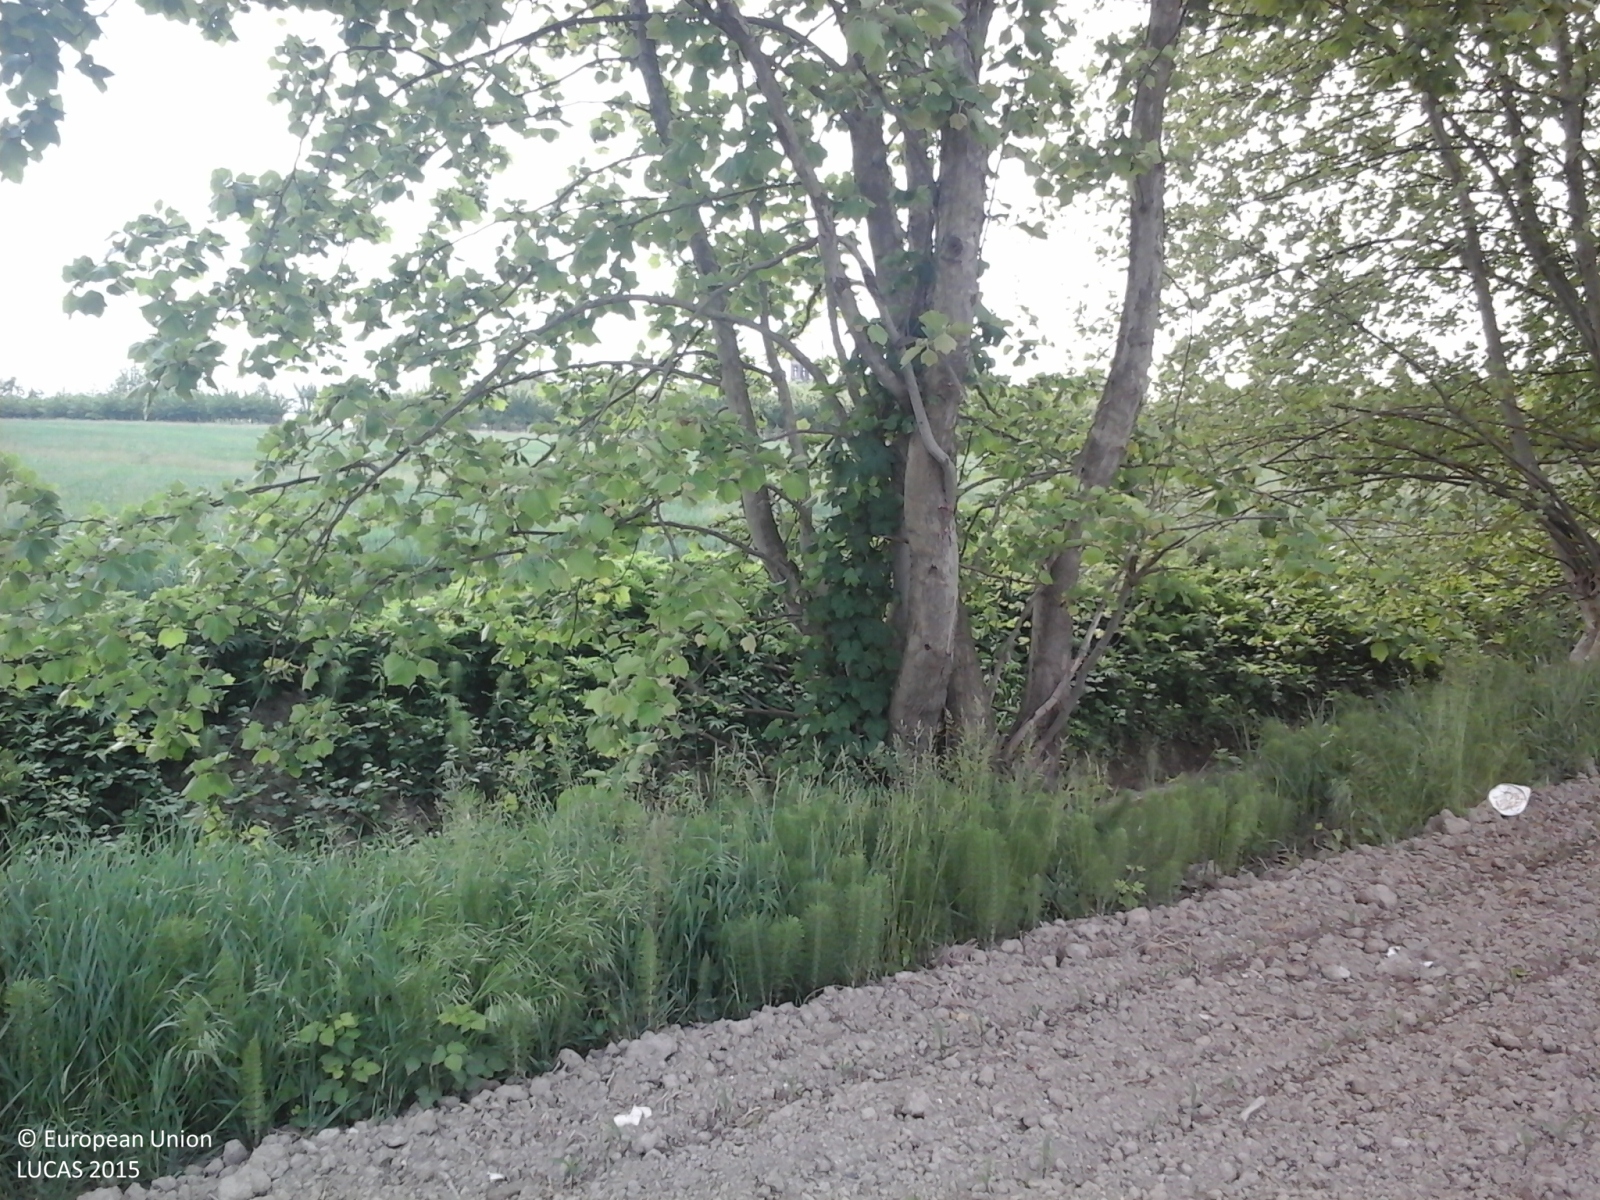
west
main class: Cropland
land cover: Maize
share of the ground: < 10 %
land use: Agriculture (excluding fallow land and kitchen gardens)
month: May
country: IT
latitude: 45.1612
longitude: 10.3936
